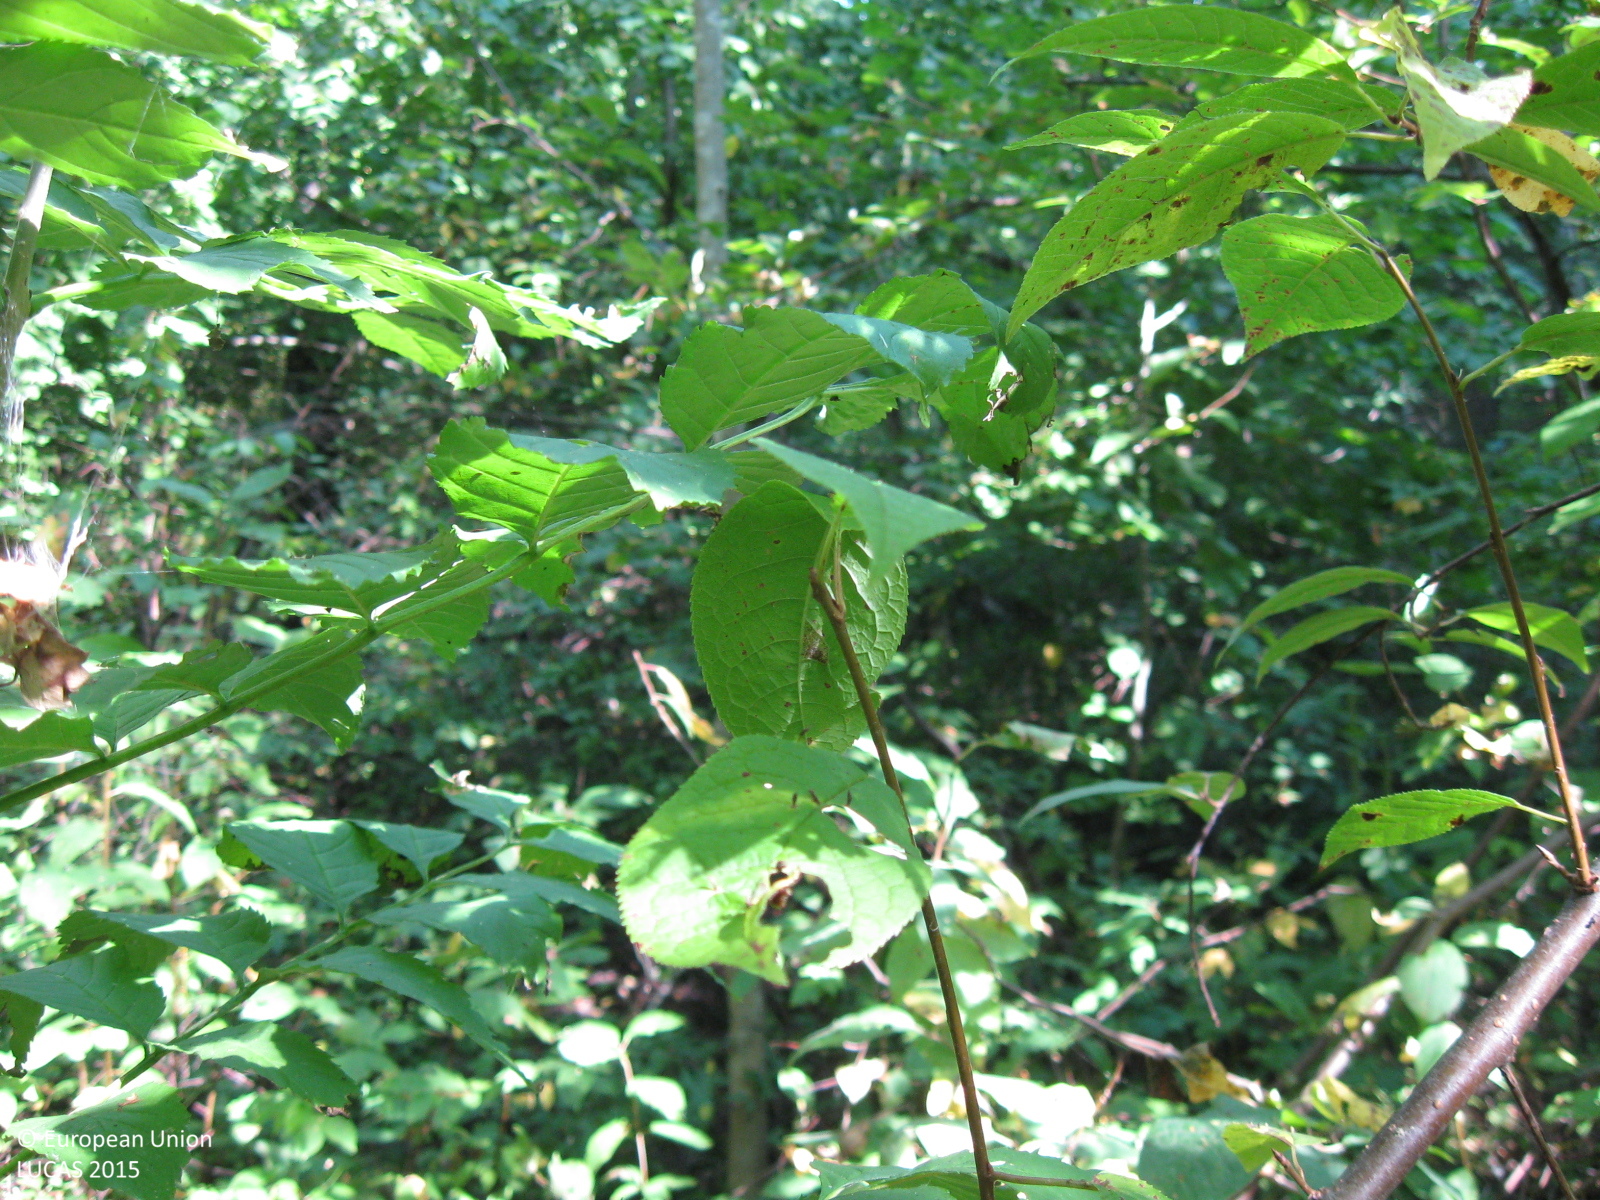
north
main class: Woodland
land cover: Broadleaved woodland
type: non-riverine alder, birch or aspen forest
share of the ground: > 75 %
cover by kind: broadleaved forest trees 95 %, herbaceous plants 5 %
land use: Forestry
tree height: > 5 m
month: August
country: LT
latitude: 55.4929
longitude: 22.9366
